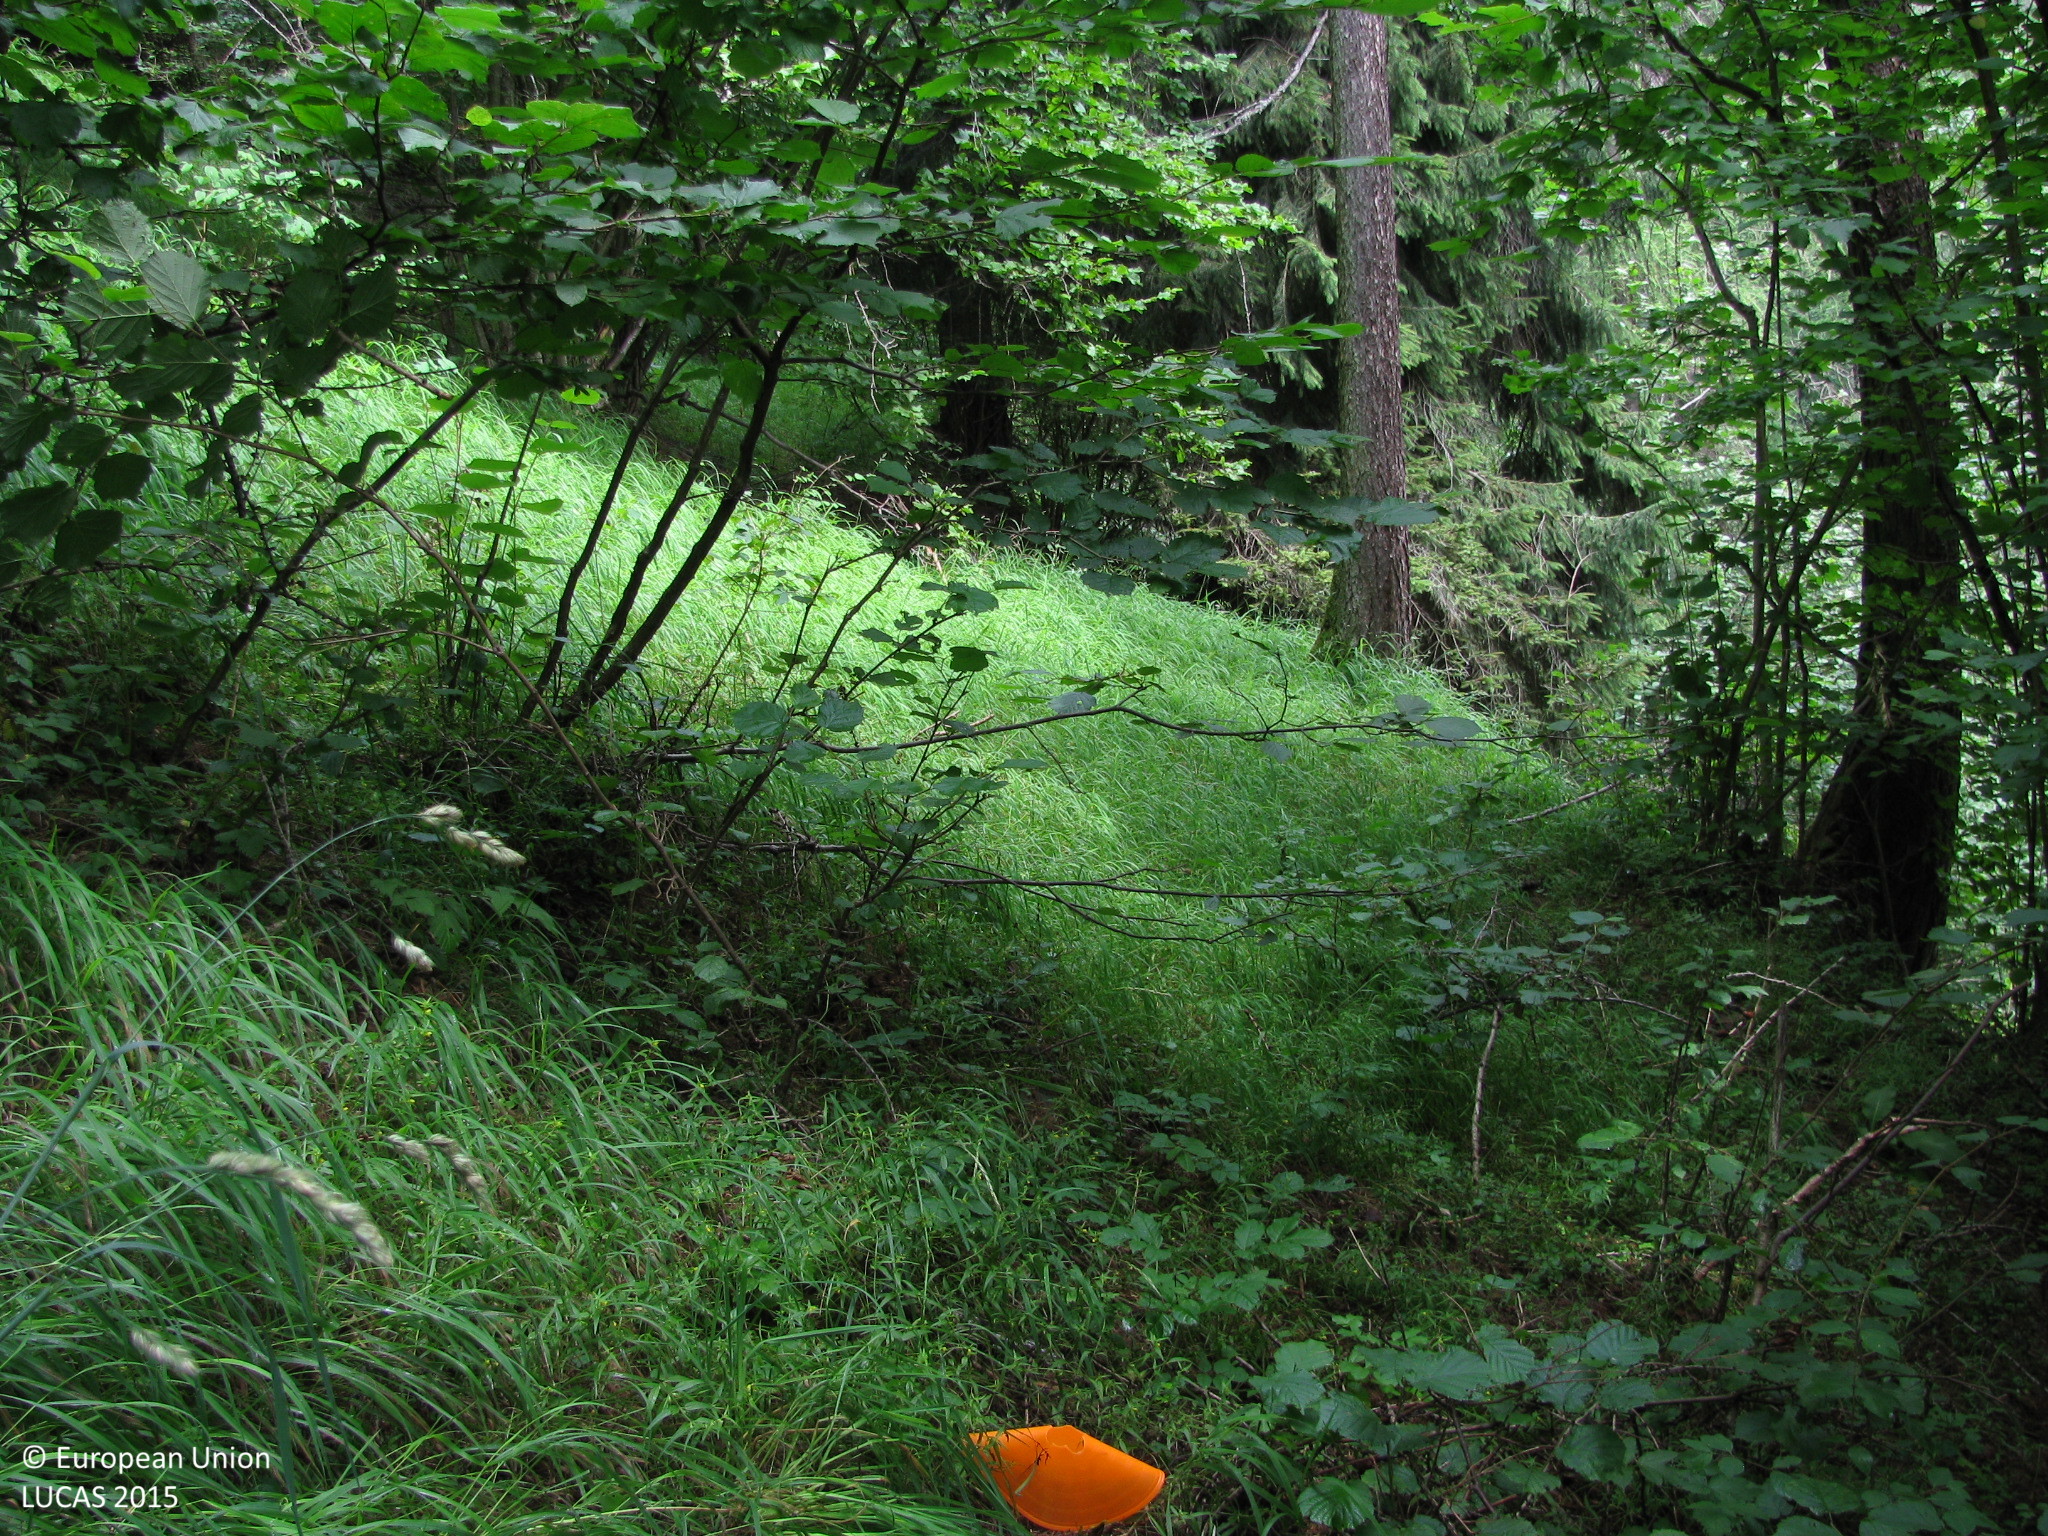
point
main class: Woodland
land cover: Other coniferous woodland
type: alpine coniferous forest
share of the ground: 50 - 75 %
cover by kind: coniferous forest trees 60 %, shrubs 30 %, herbaceous plants 10 %
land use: Forestry
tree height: > 5 m
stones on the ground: < 10 %
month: July
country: AT
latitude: 47.0339
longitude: 12.8534
